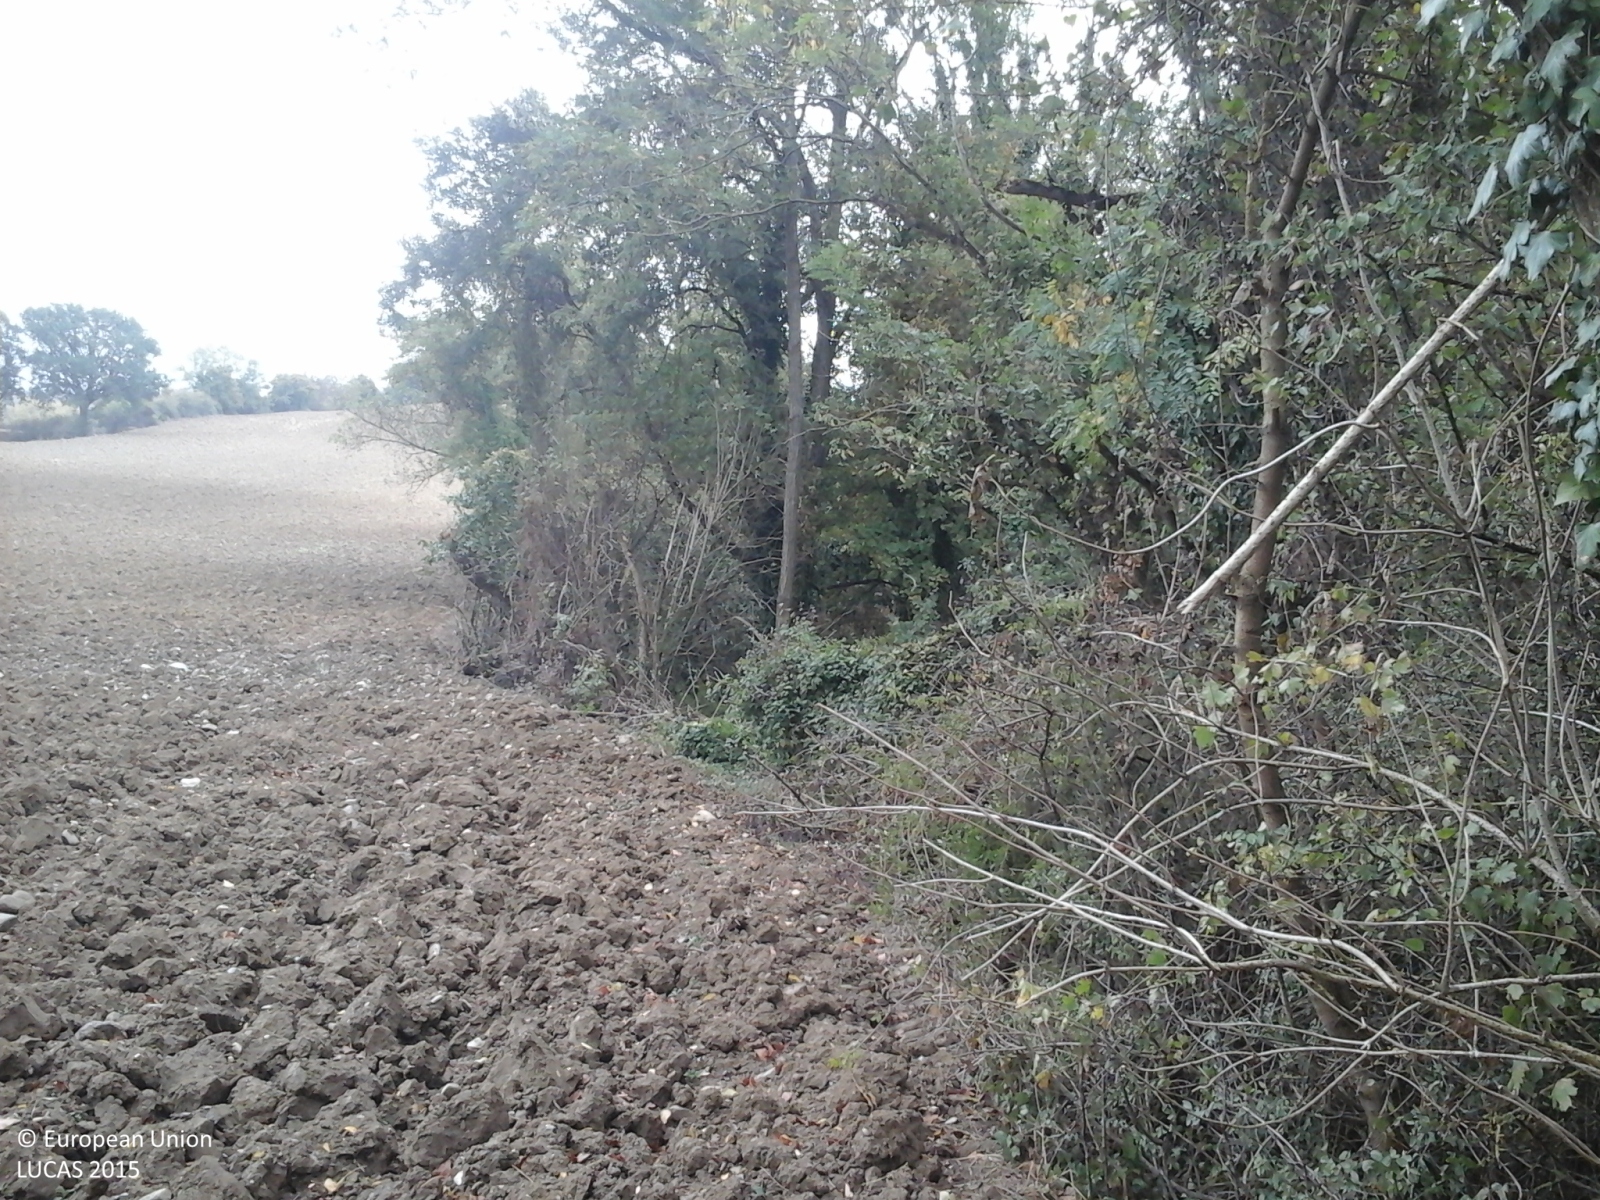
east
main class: Woodland
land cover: Broadleaved woodland
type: thermophilous deciduous forest
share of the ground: > 75 %
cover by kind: broadleaved forest trees 80 %, shrubs 15 %, herbaceous plants 5 %
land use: Forestry
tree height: > 5 m
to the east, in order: Broadleaved woodland; Other bare soil
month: October
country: IT
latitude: 43.3312
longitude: 12.3492
